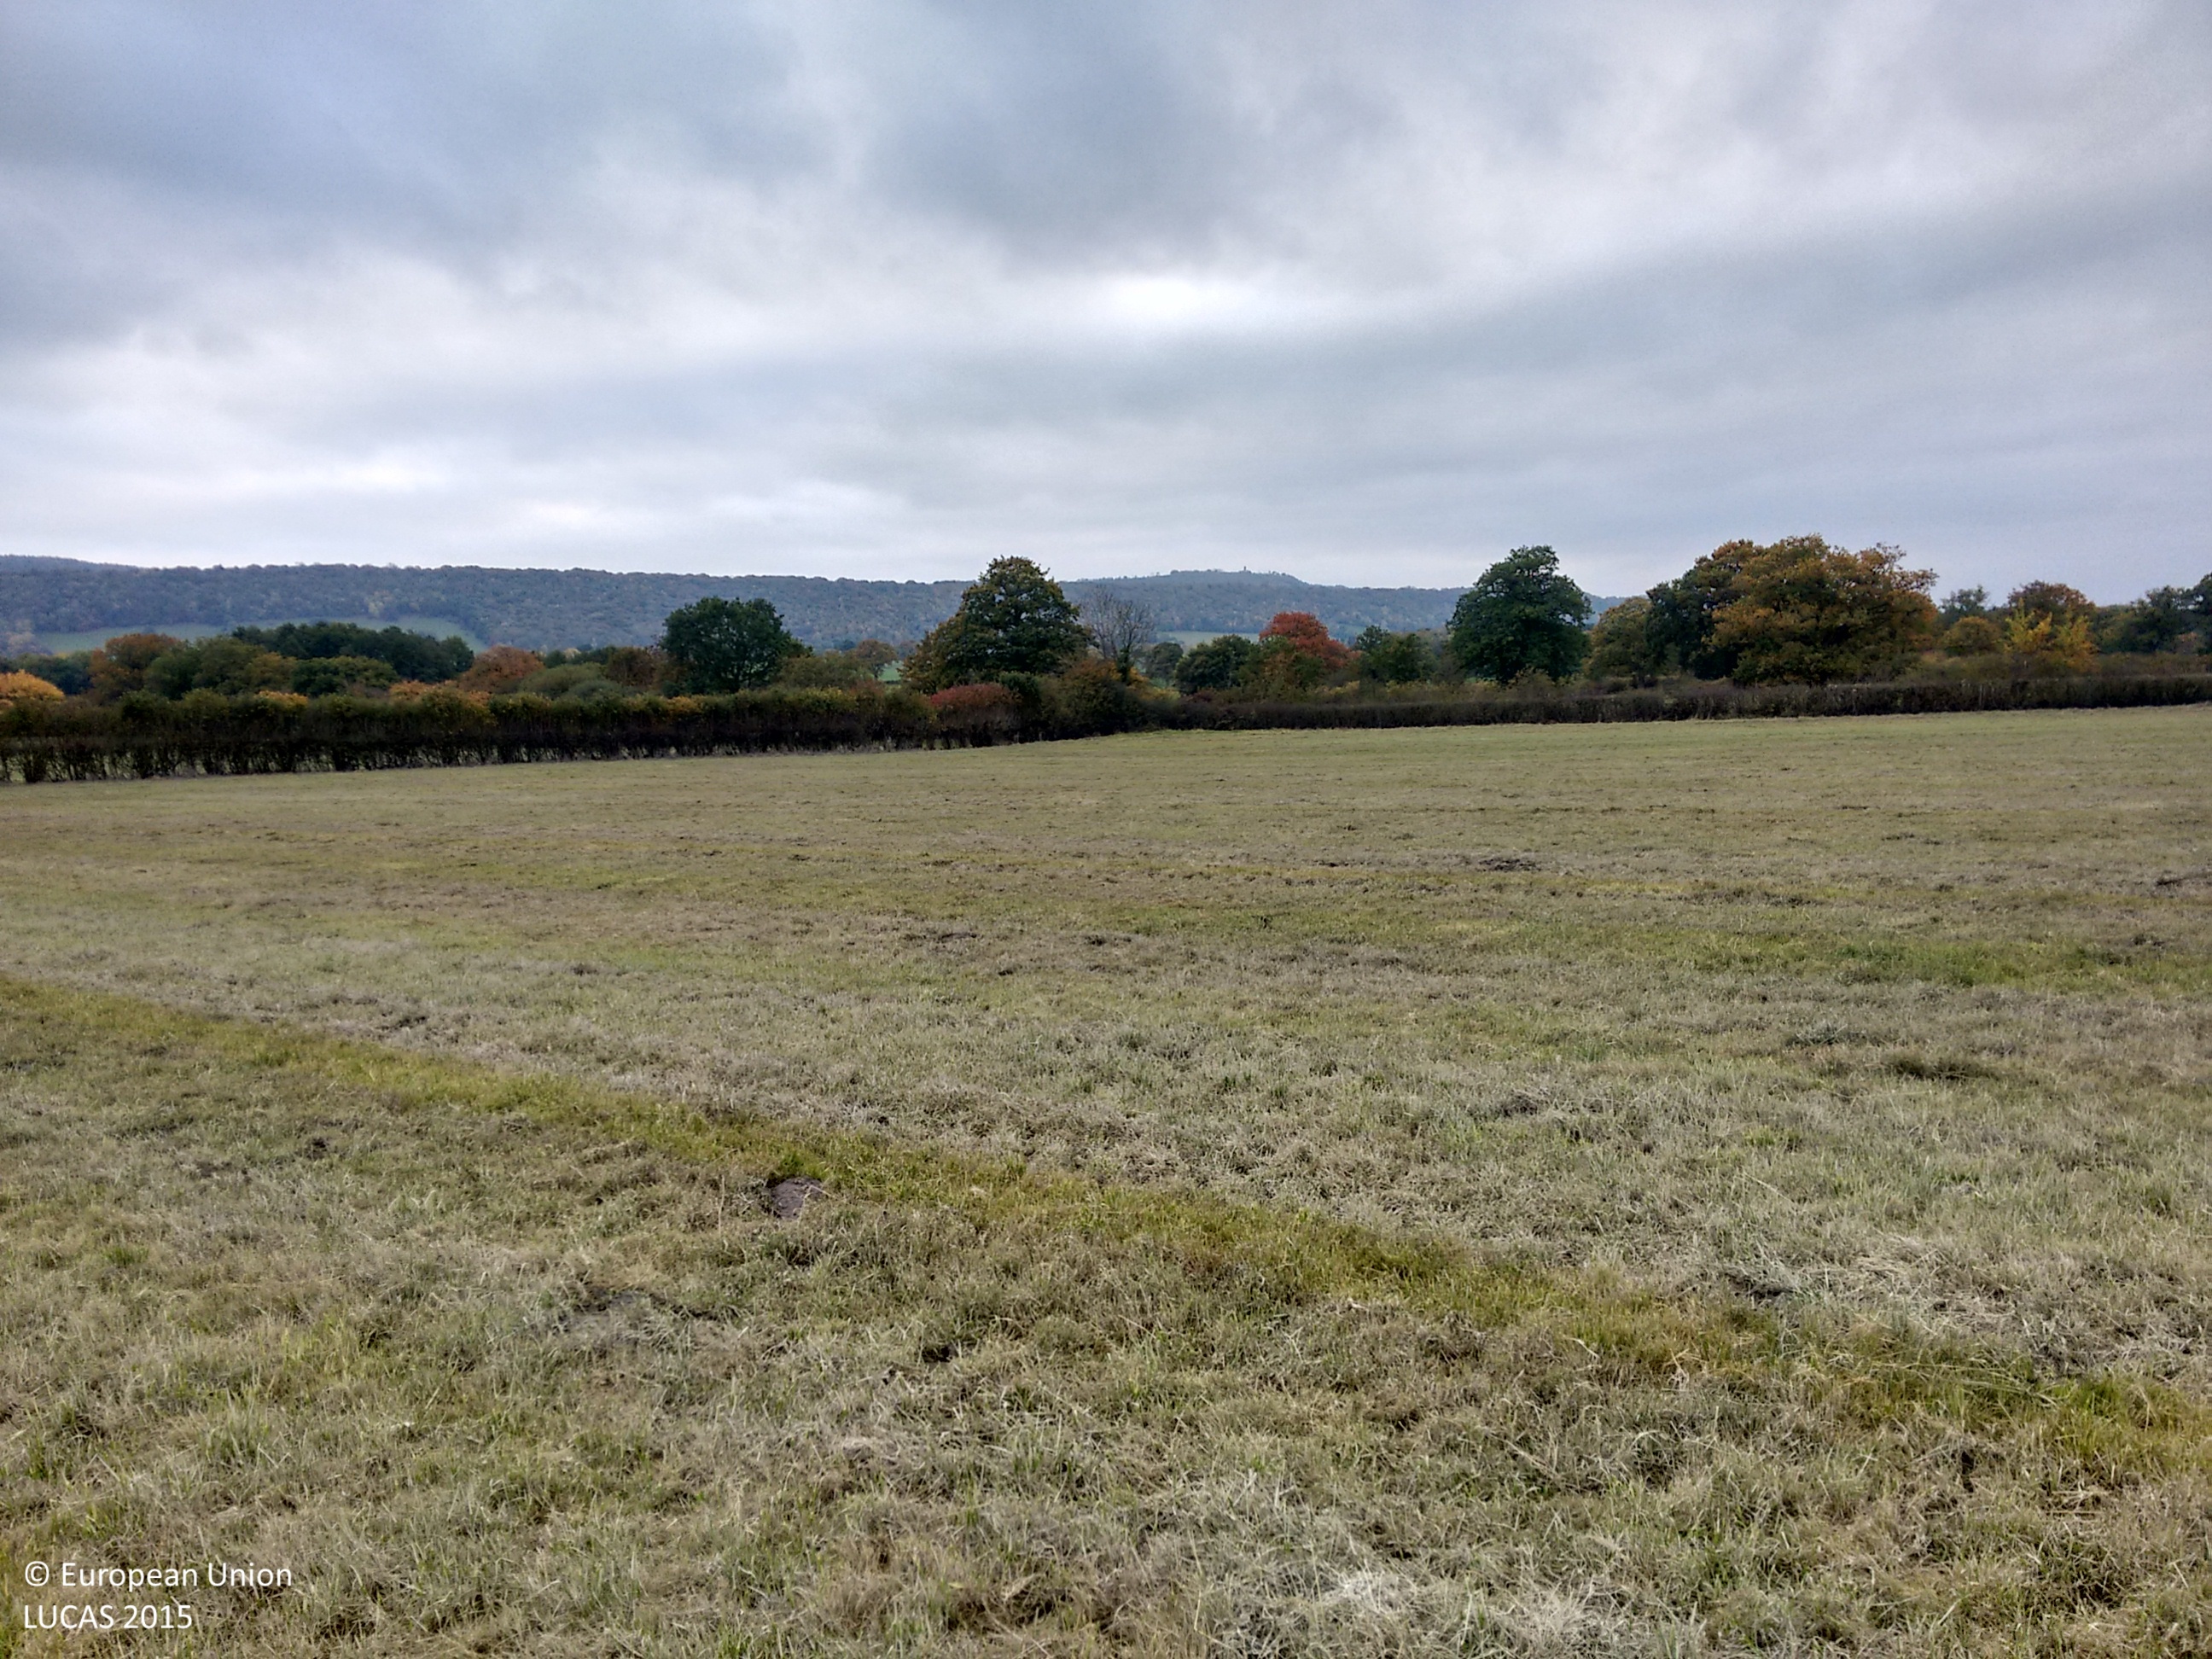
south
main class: Grassland
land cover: Grassland without tree/shrub cover
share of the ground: > 75 %
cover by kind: herbaceous plants 100 %
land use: Agriculture (excluding fallow land and kitchen gardens)
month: October
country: GB
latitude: 52.5022
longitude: -2.7844
